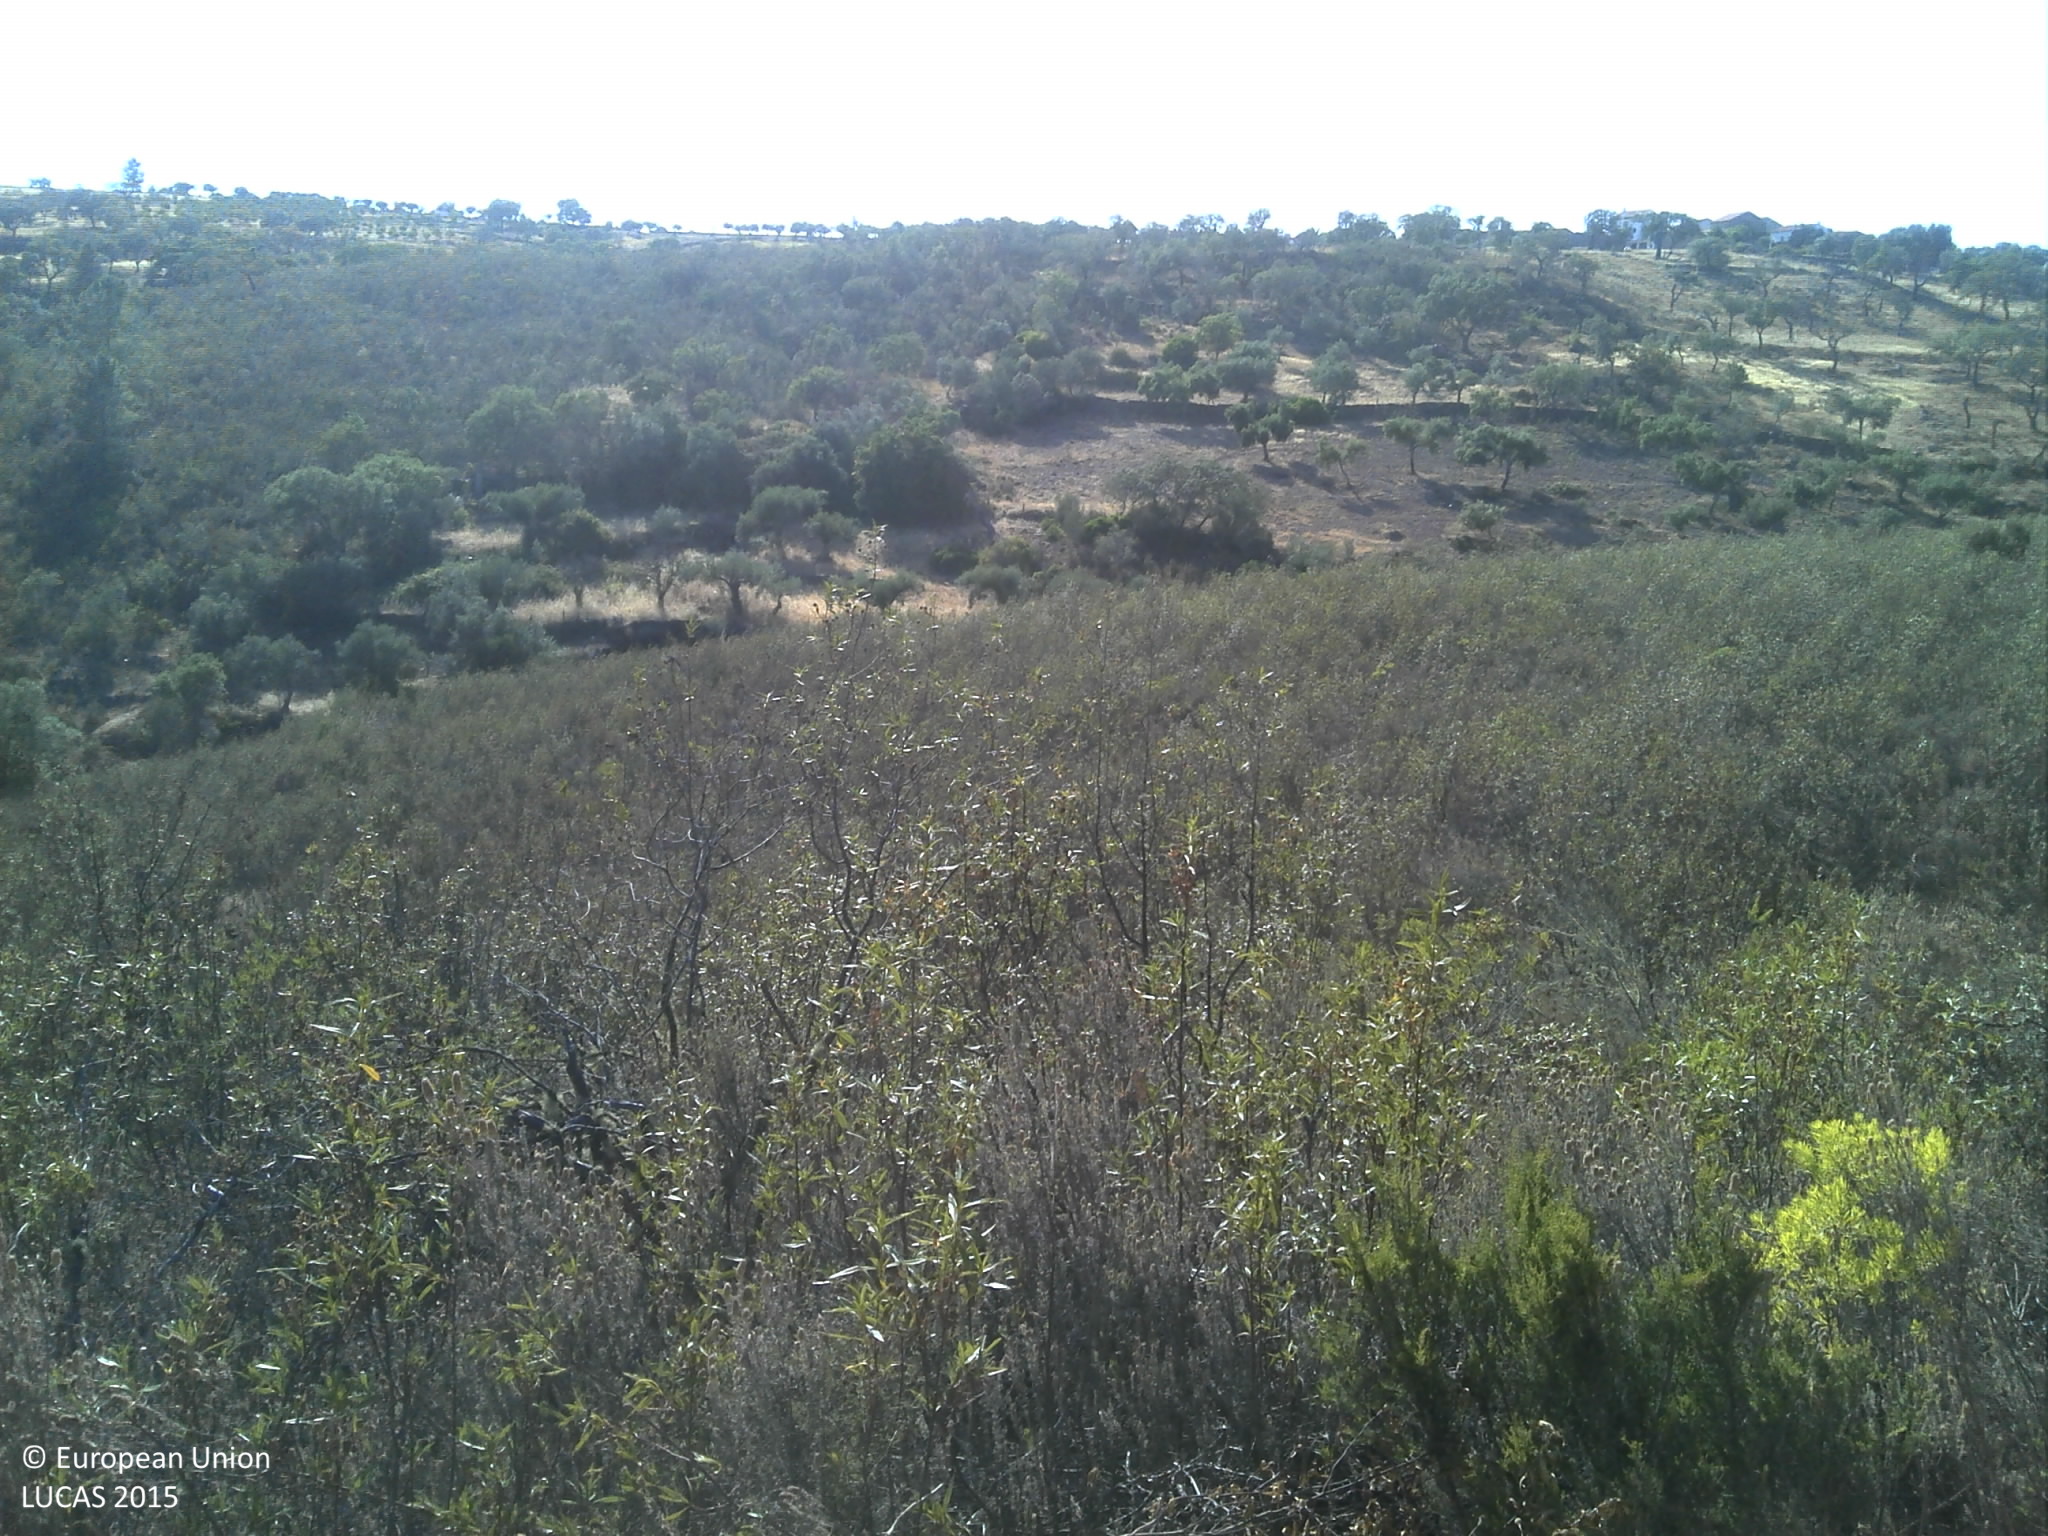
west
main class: Shrubland
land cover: Shrubland without tree cover
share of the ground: > 75 %
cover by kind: shrubs 85 %, unconsolidated bare surface 10 %, herbaceous plants 5 %
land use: Abandoned areas
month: July
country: PT
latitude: 39.6728
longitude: -7.5256
